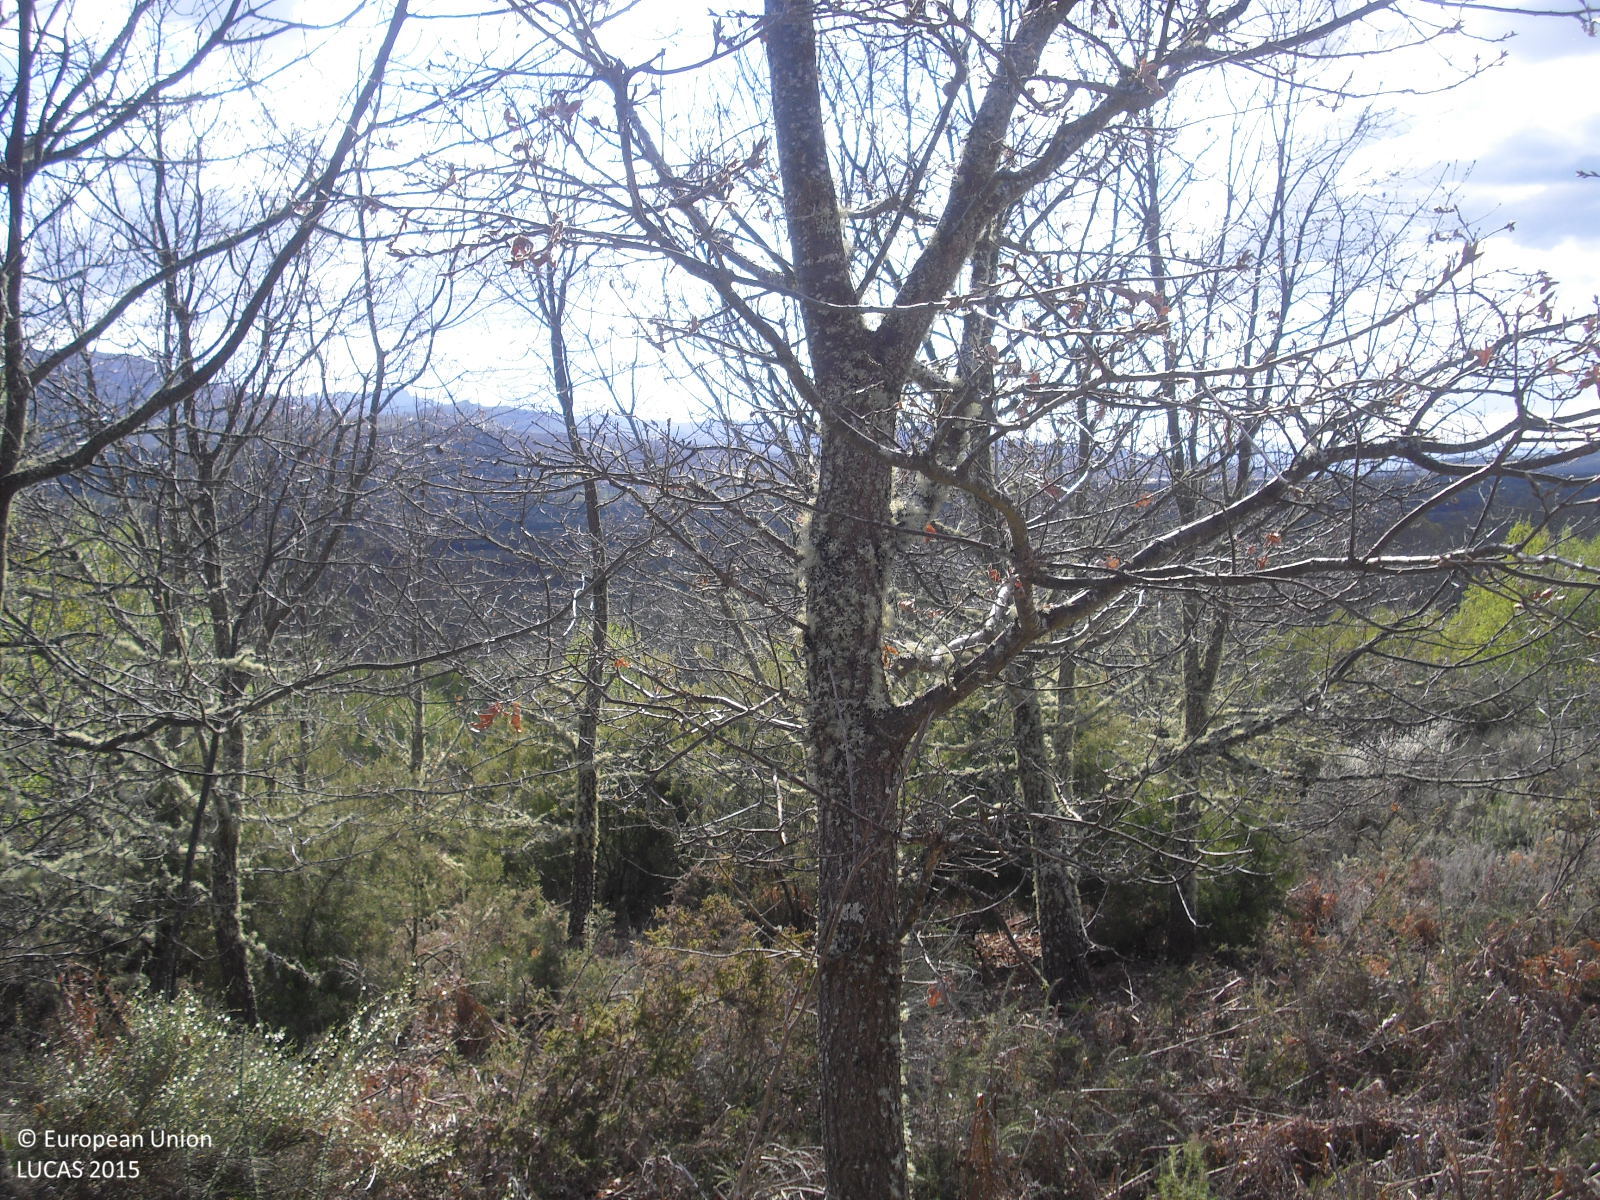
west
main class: Woodland
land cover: Broadleaved woodland
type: acidophilous oak and oak-birch forest
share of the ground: 25 - 50 %
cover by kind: shrubs 50 %, broadleaved forest trees 40 %, herbaceous plants 10 %
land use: Semi-natural and natural areas not in use
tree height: > 5 m
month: April
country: ES
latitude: 41.9193
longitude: -7.8559
